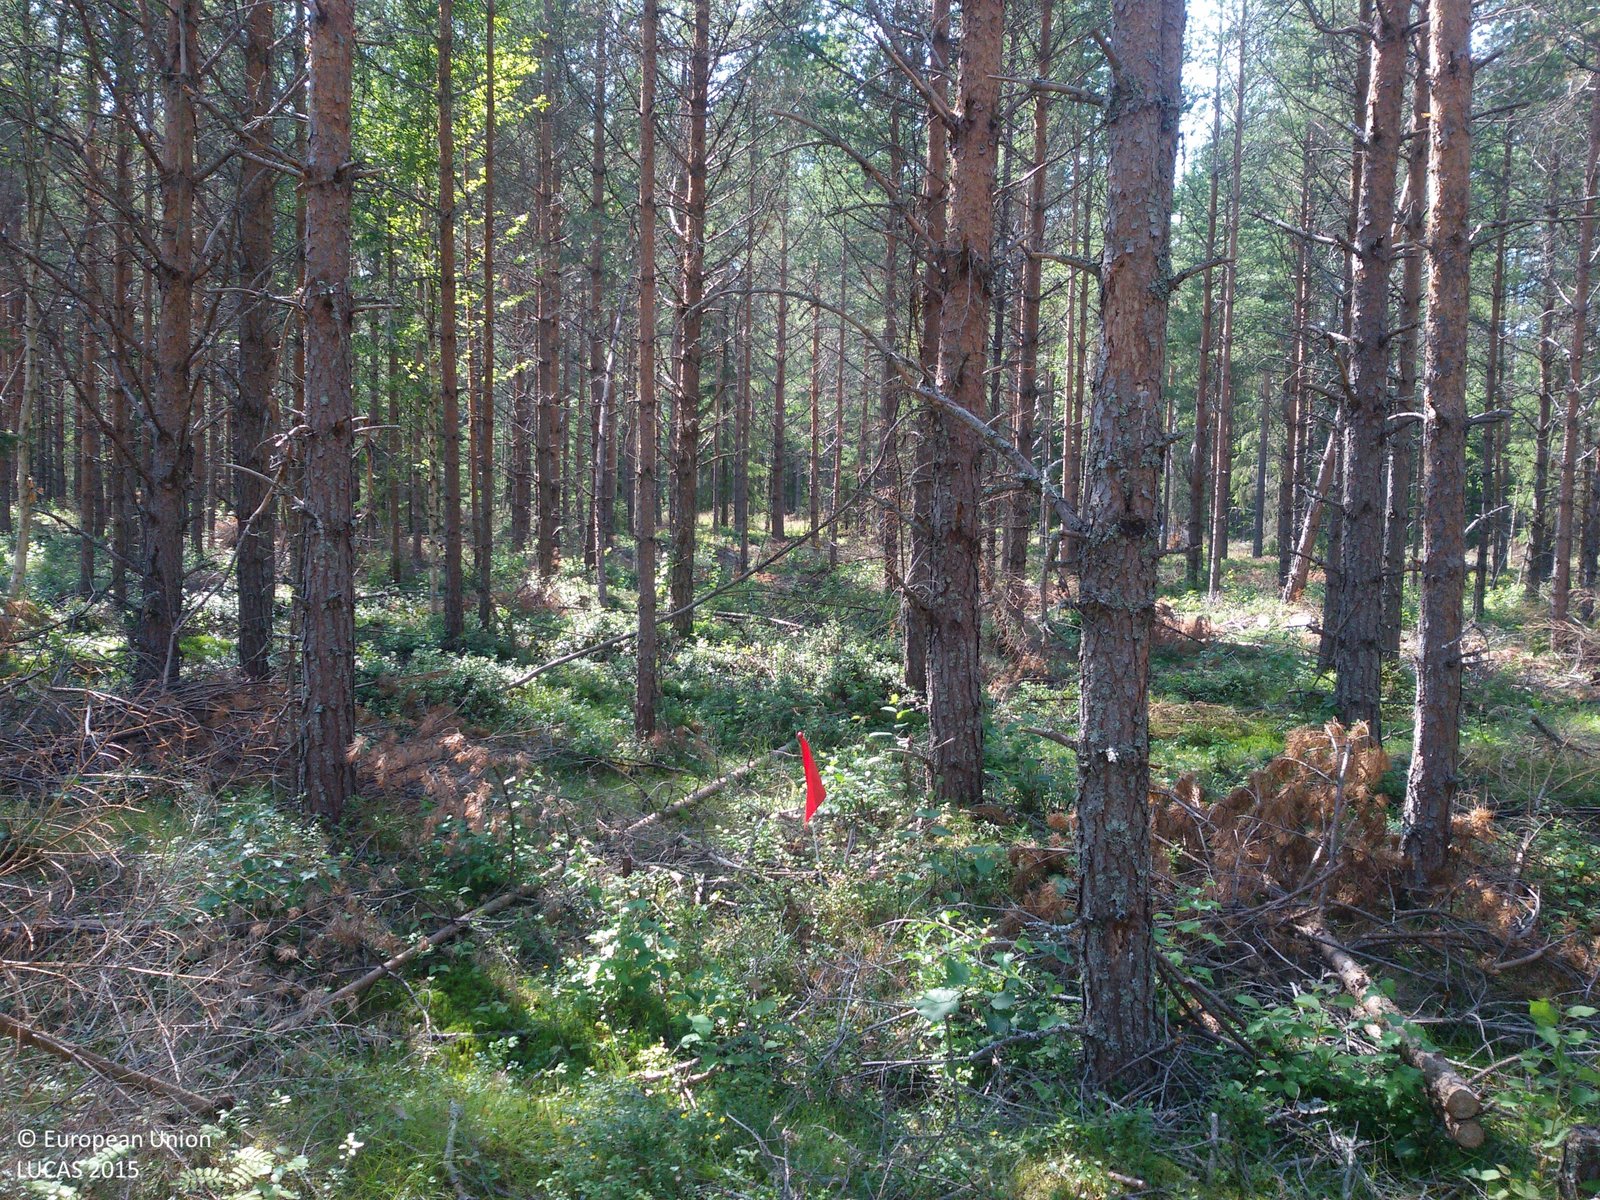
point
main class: Woodland
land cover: Pine dominated coniferous woodland
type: boreal forest
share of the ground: > 75 %
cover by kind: coniferous forest trees 80 %, shrubs 20 %
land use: Forestry
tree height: > 5 m
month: August
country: SE
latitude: 60.4800
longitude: 16.5569
